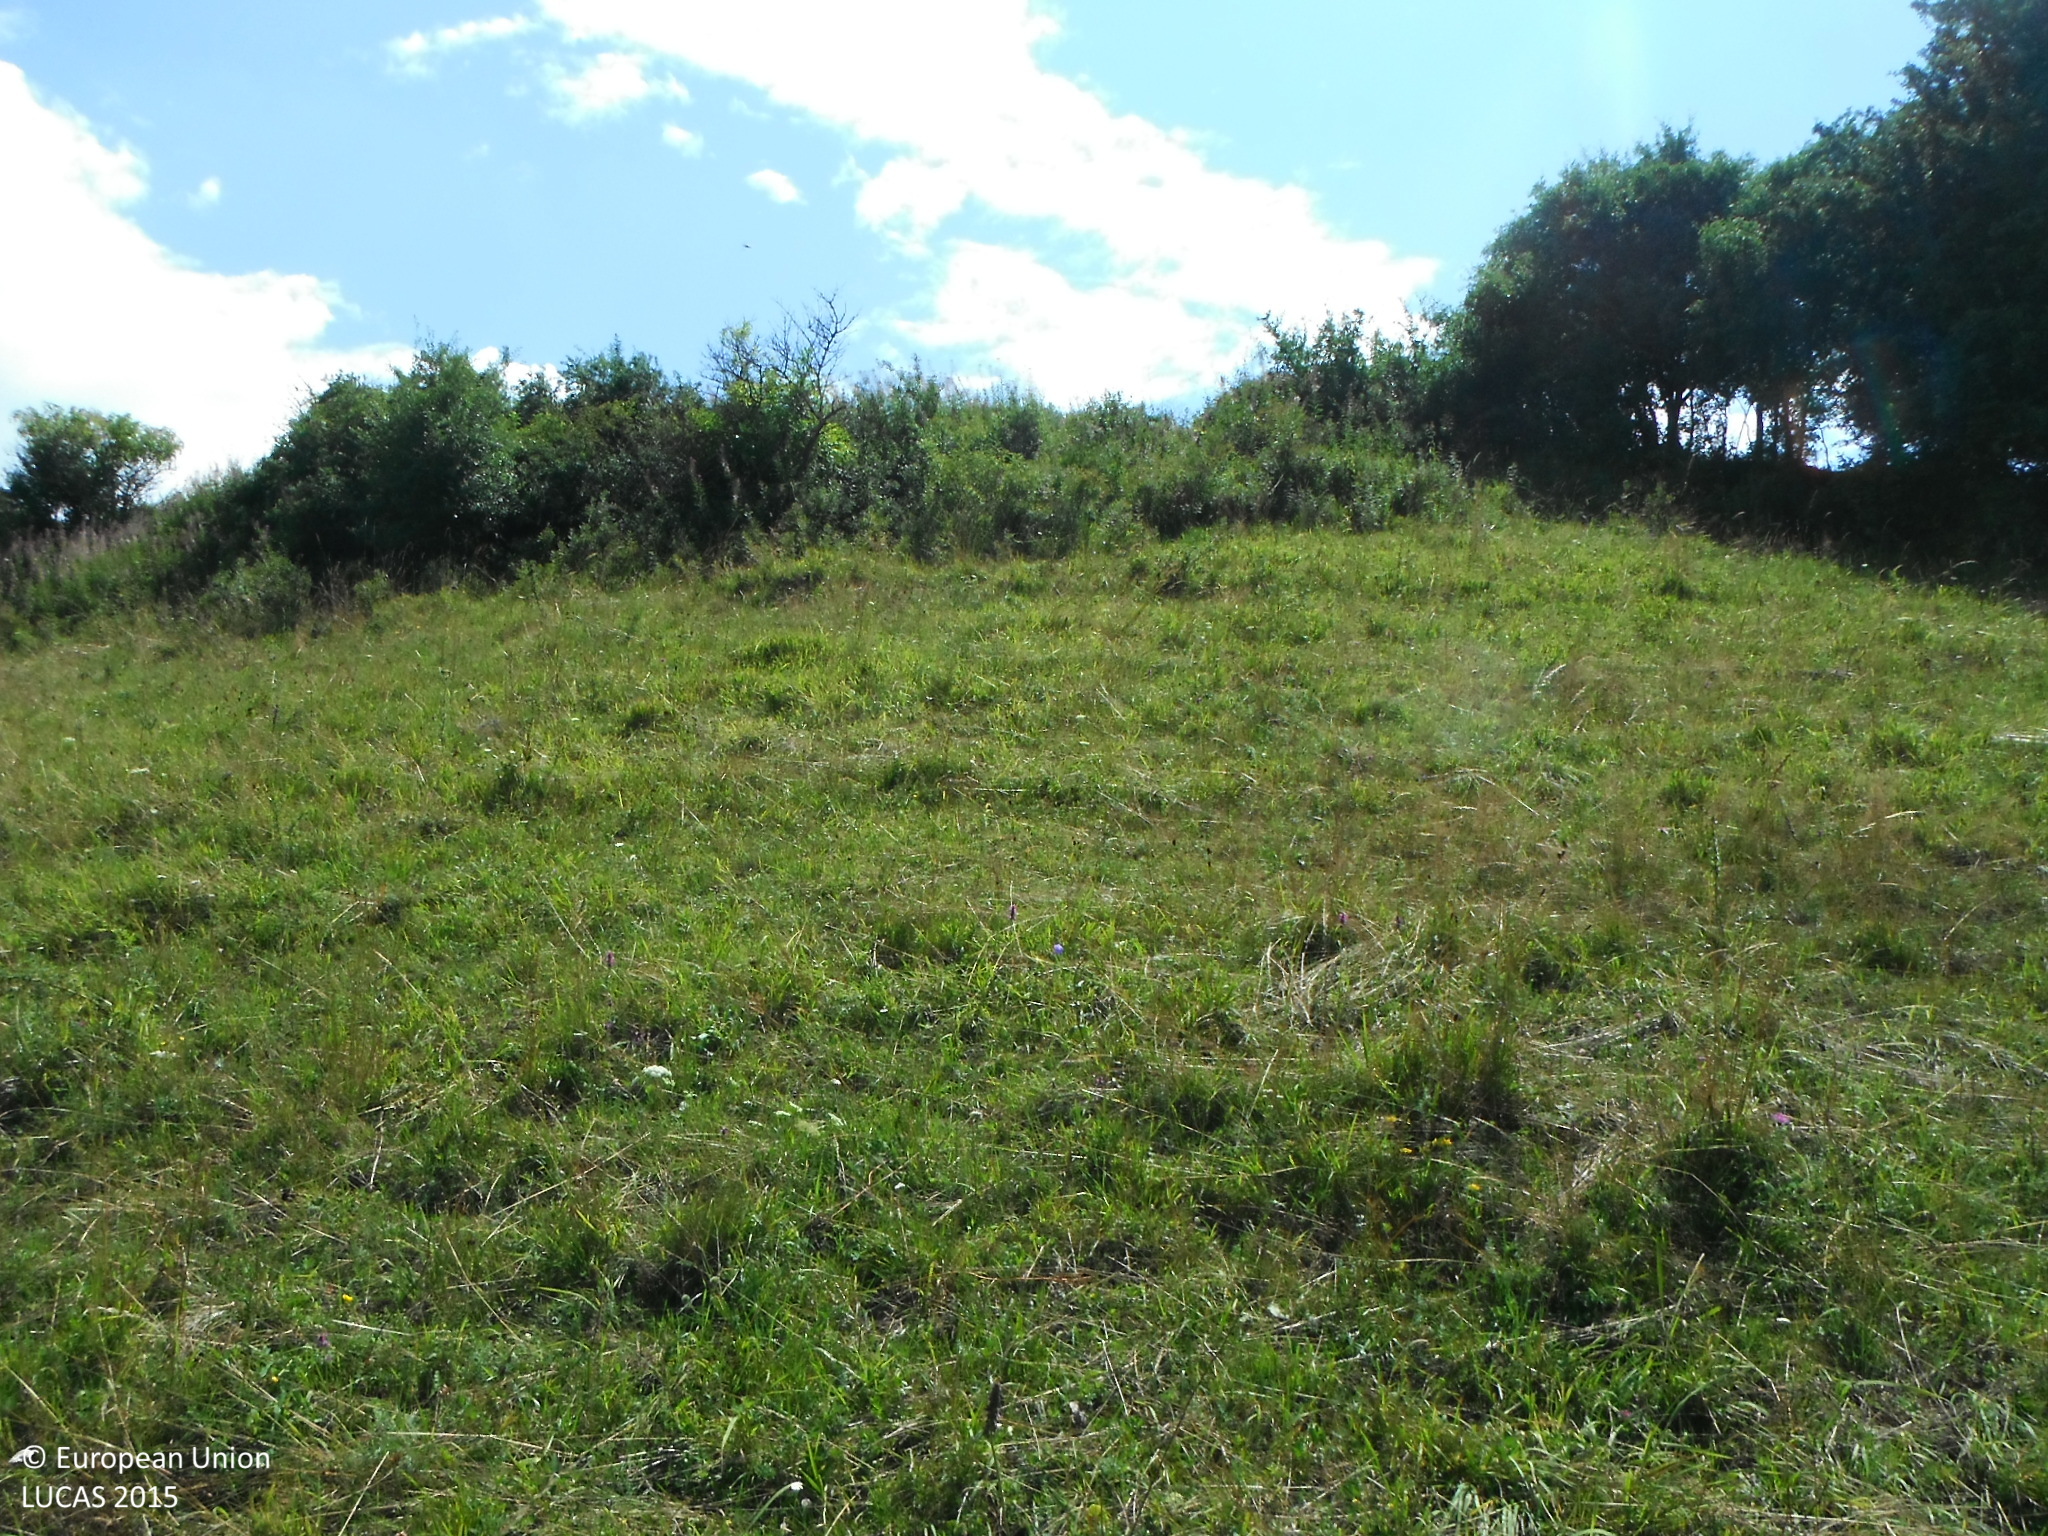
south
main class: Grassland
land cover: Grassland without tree/shrub cover
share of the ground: > 75 %
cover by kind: herbaceous plants 100 %
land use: Agriculture (excluding fallow land and kitchen gardens)
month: July
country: SK
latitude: 48.9912
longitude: 20.6843
